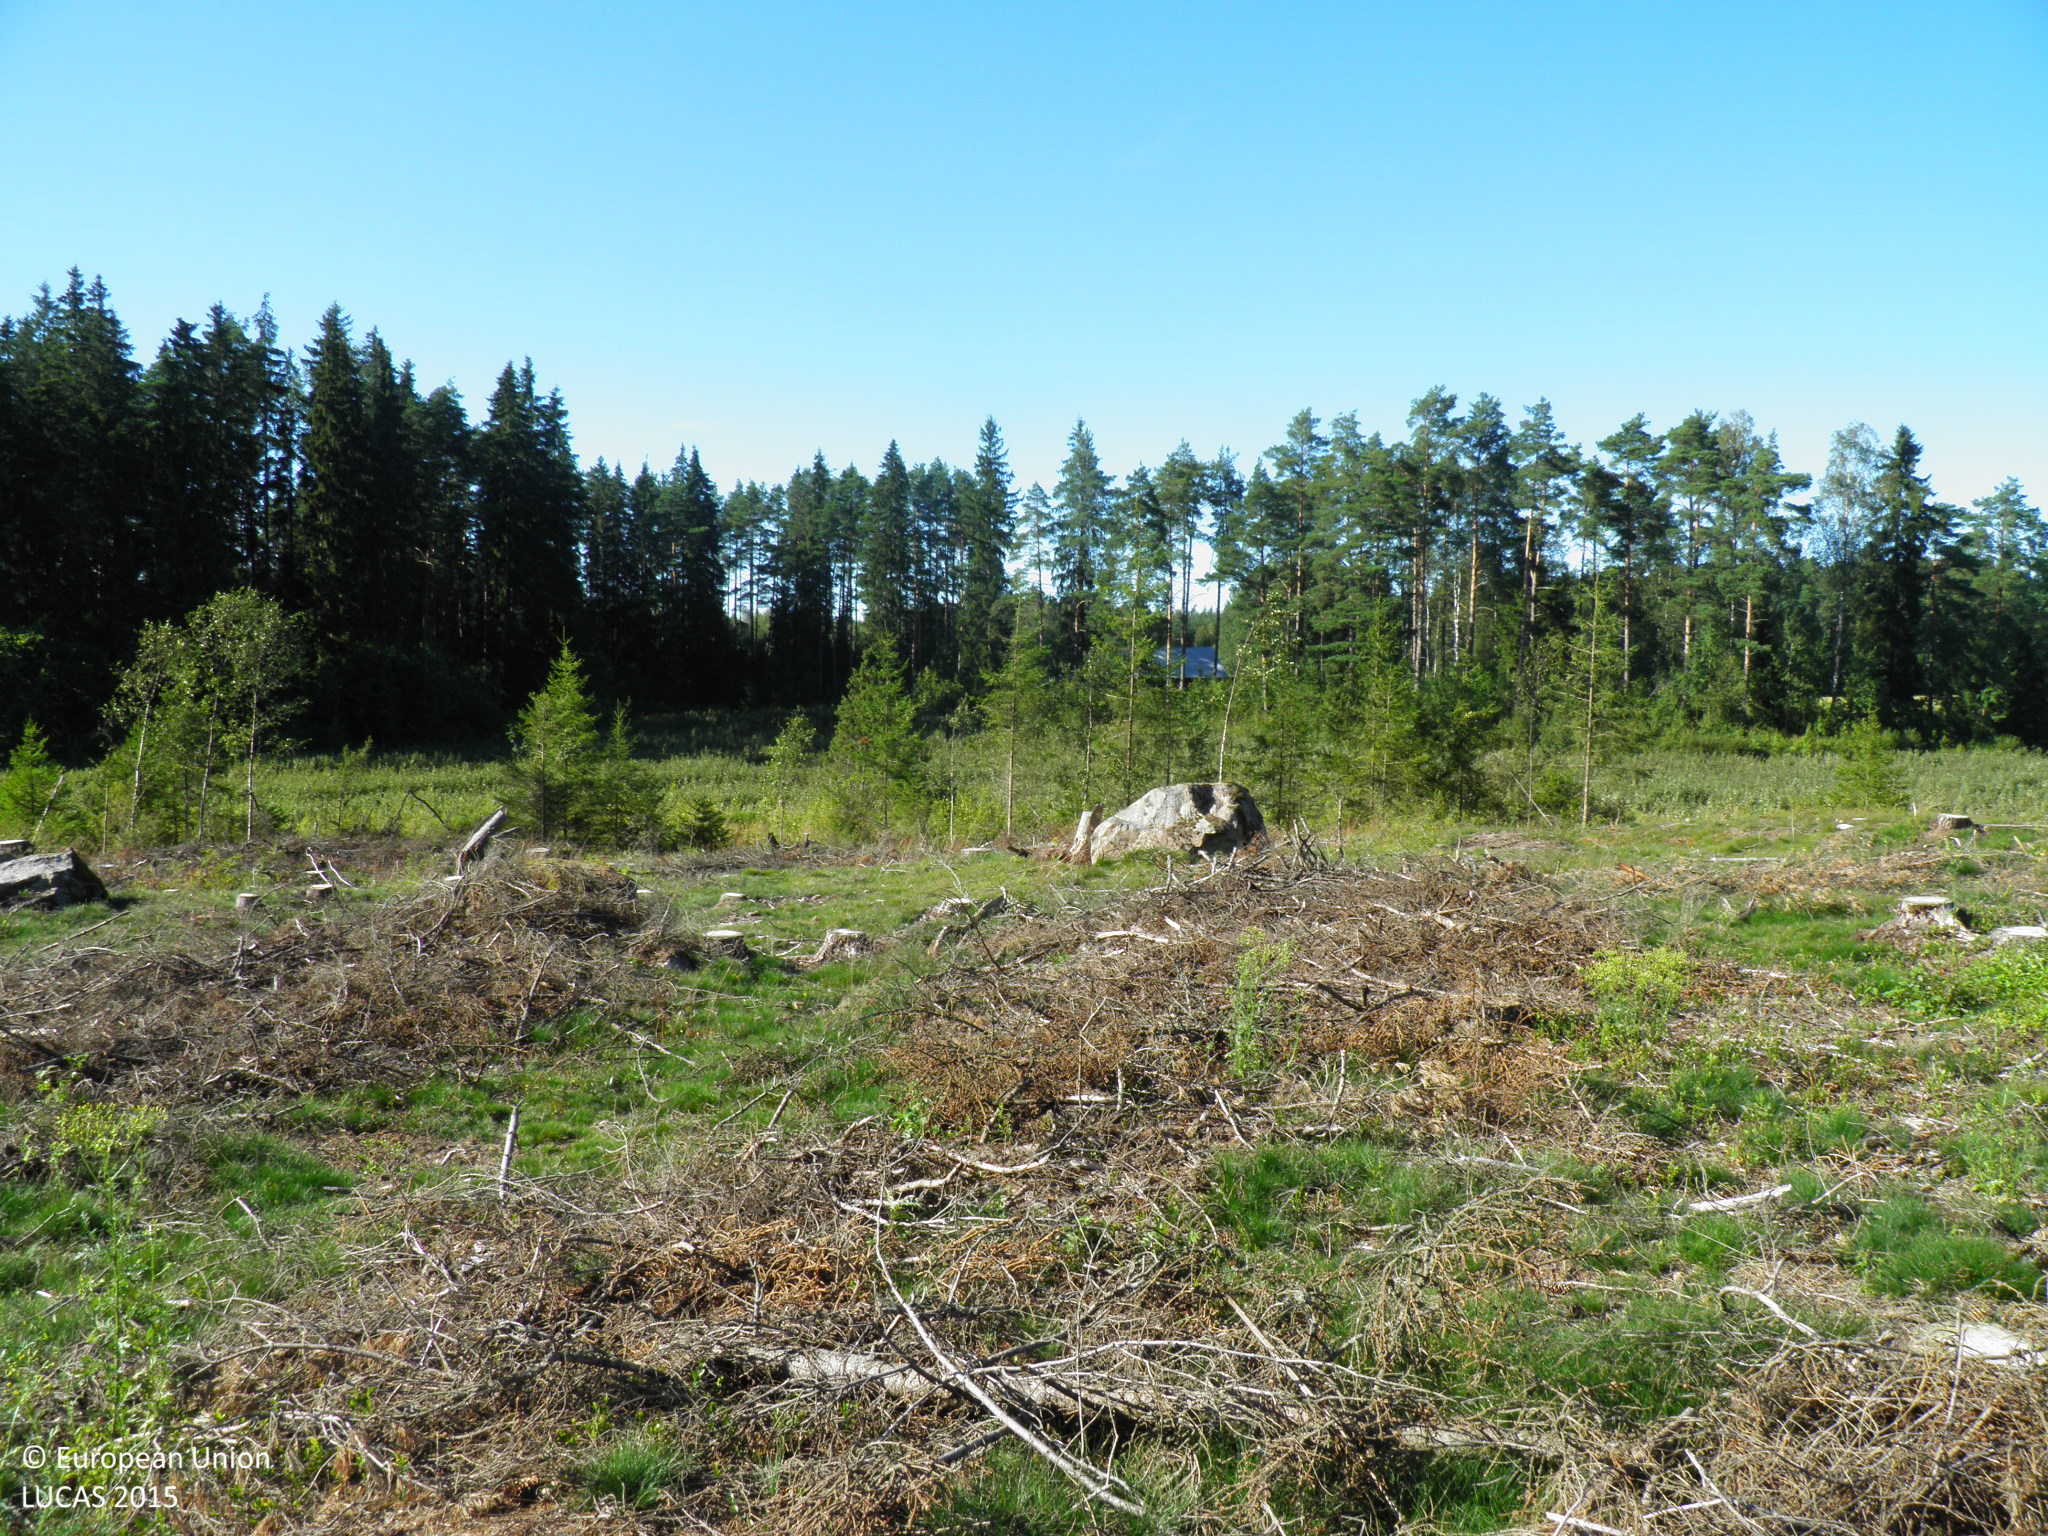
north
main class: Grassland
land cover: Spontaneously vegetated surfaces
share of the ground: 10 - 25 %
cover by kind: unconsolidated bare surface 40 %, herbaceous plants 15 %, shrubs 5 %
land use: Forestry
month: August
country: FI
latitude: 60.7103
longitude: 21.7309
